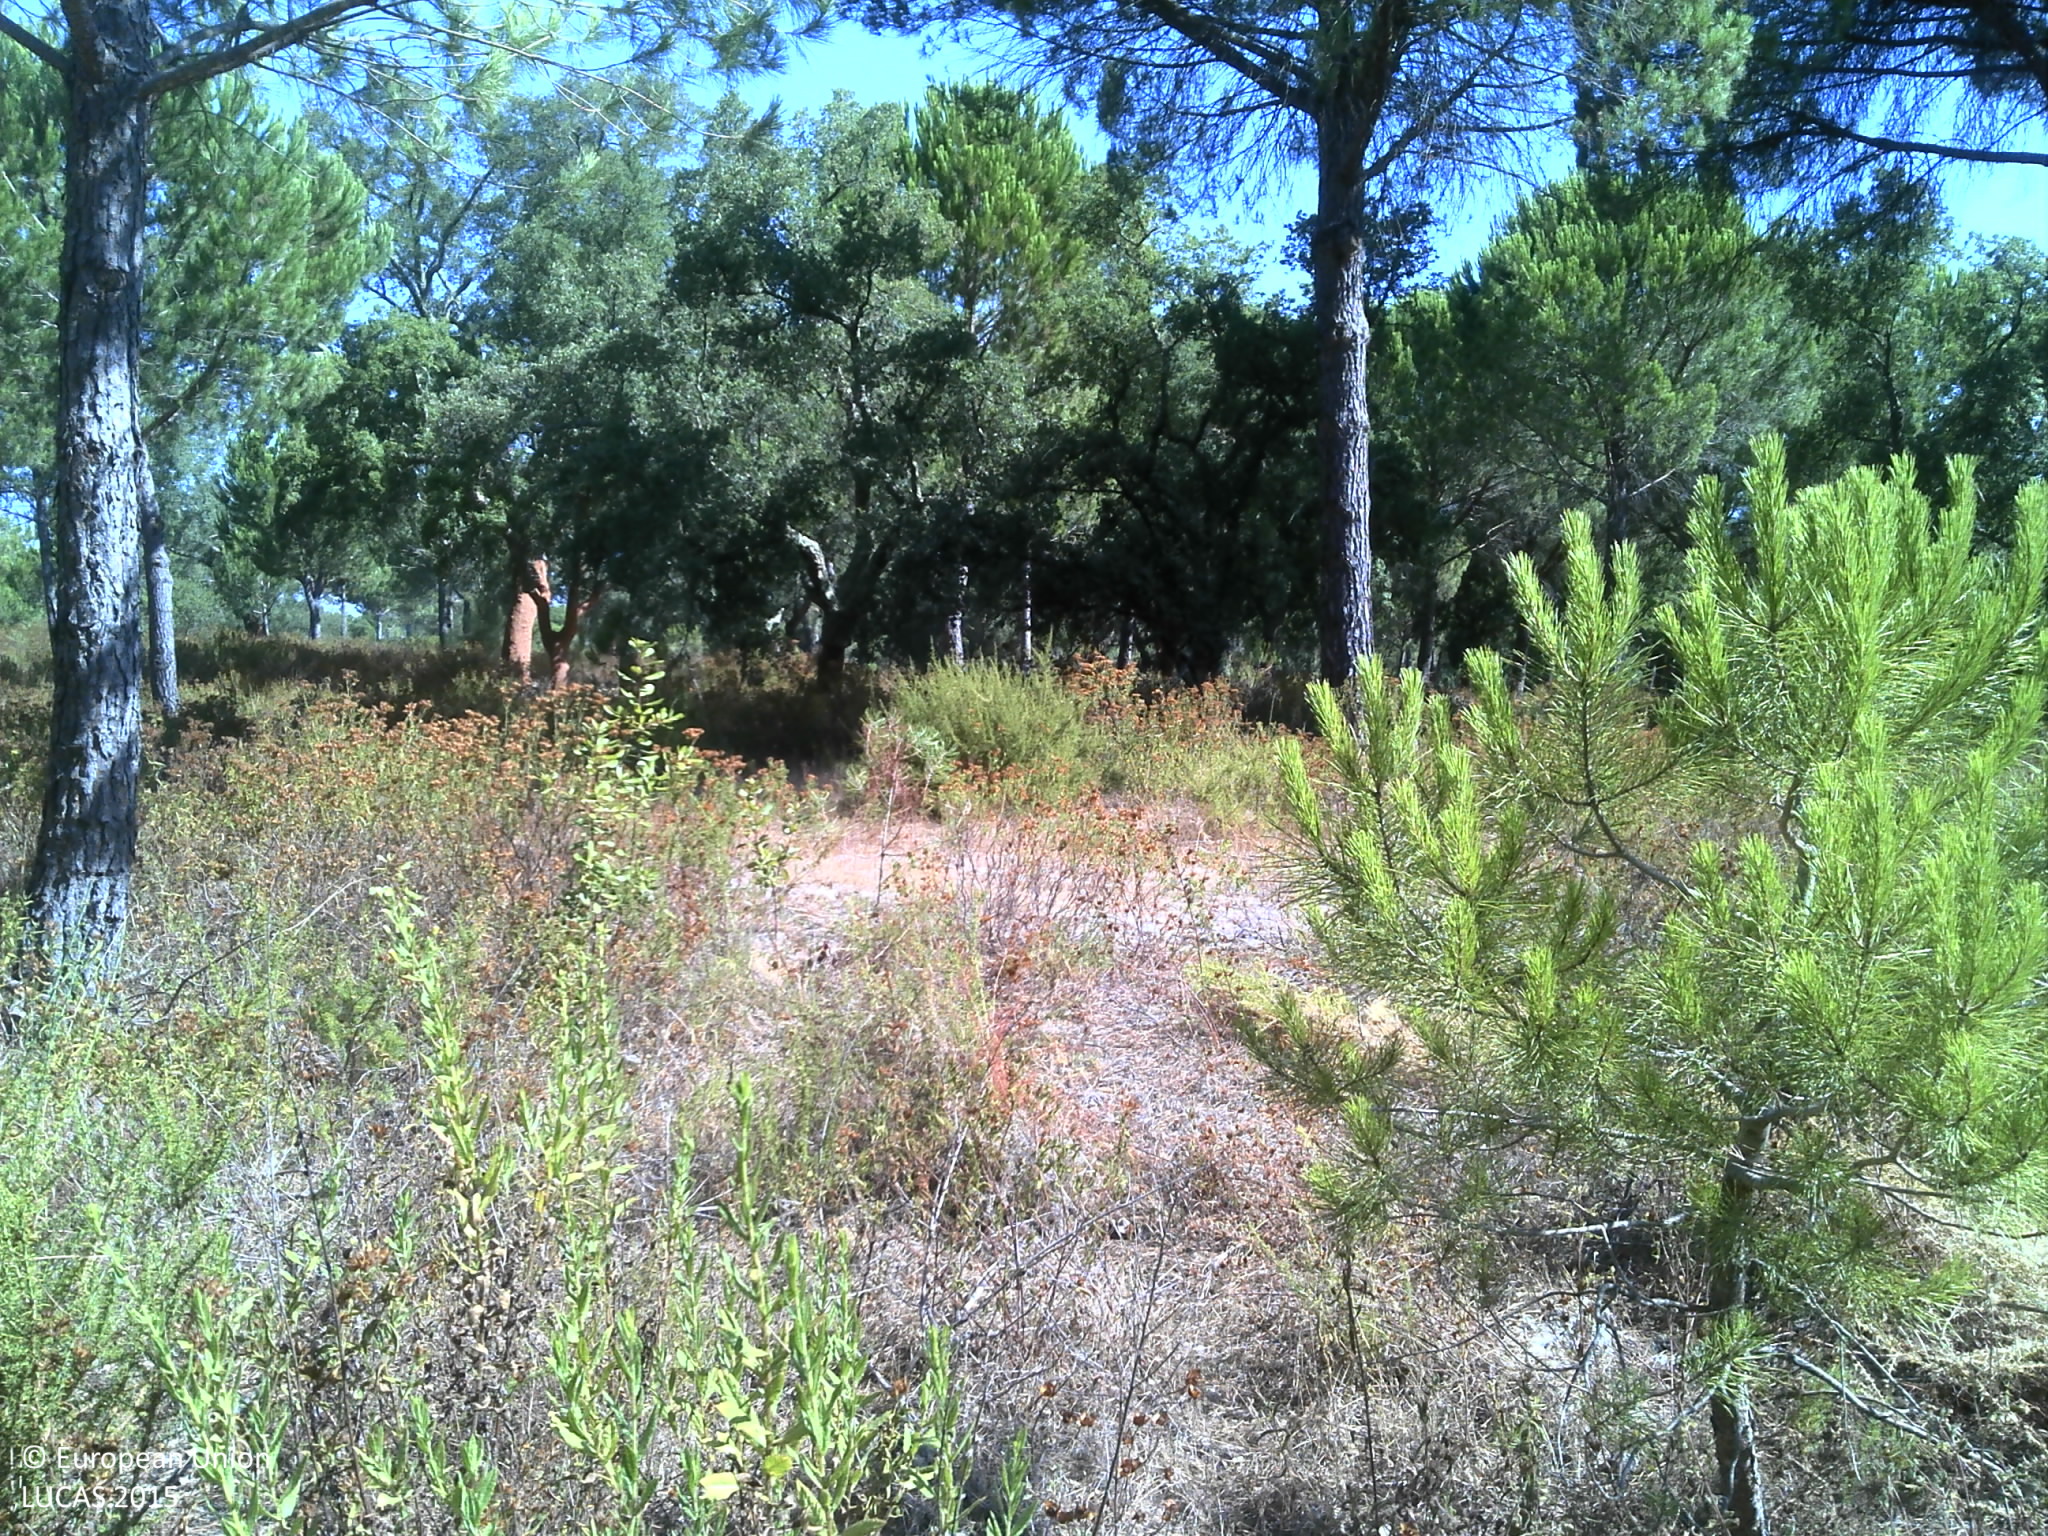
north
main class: Woodland
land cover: Pine dominated coniferous woodland
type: coniferous forest of the mediterranean region
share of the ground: 25 - 50 %
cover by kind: coniferous forest trees 45 %, unconsolidated bare surface 30 %, herbaceous plants 15 %, shrubs 10 %
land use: Forestry
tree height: > 5 m
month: August
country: PT
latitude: 38.6440
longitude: -8.5670
